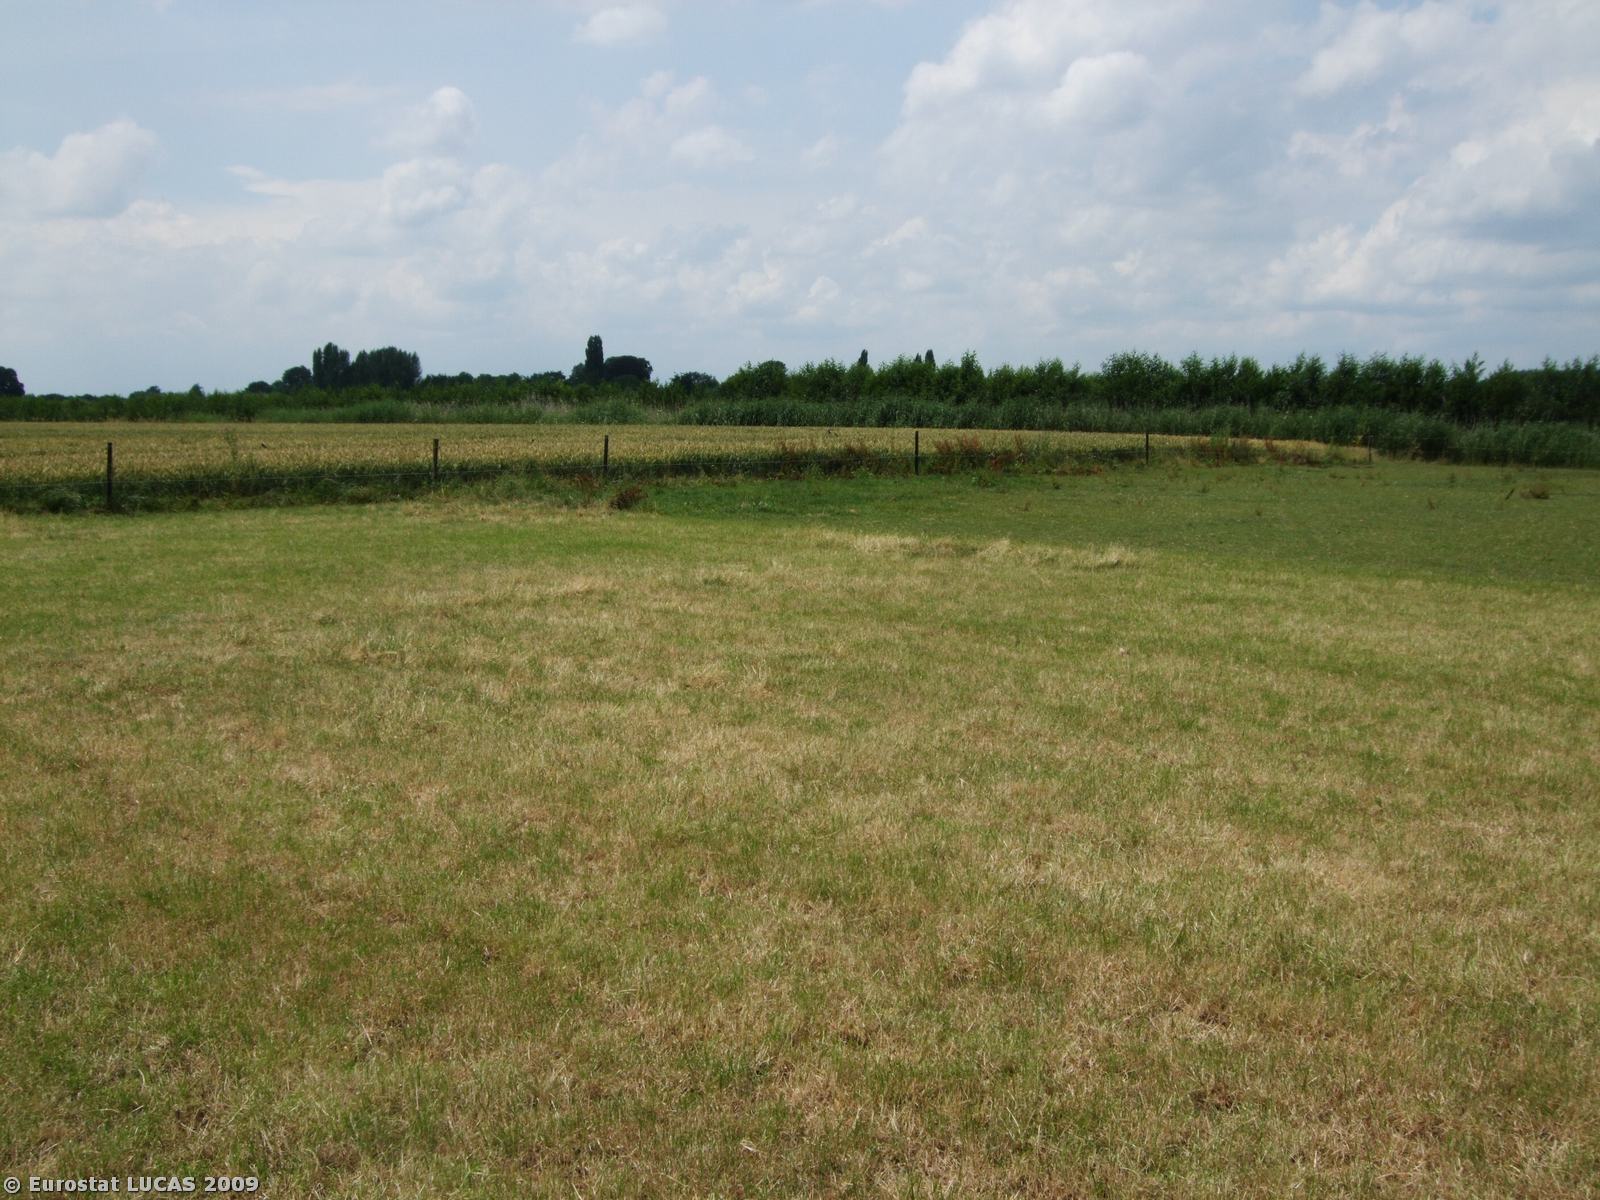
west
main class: Grassland
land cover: Grassland without tree/shrub cover
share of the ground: > 75 %
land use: Agriculture (excluding fallow land and kitchen gardens)
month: July
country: NL
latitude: 51.8897
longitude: 5.3338
